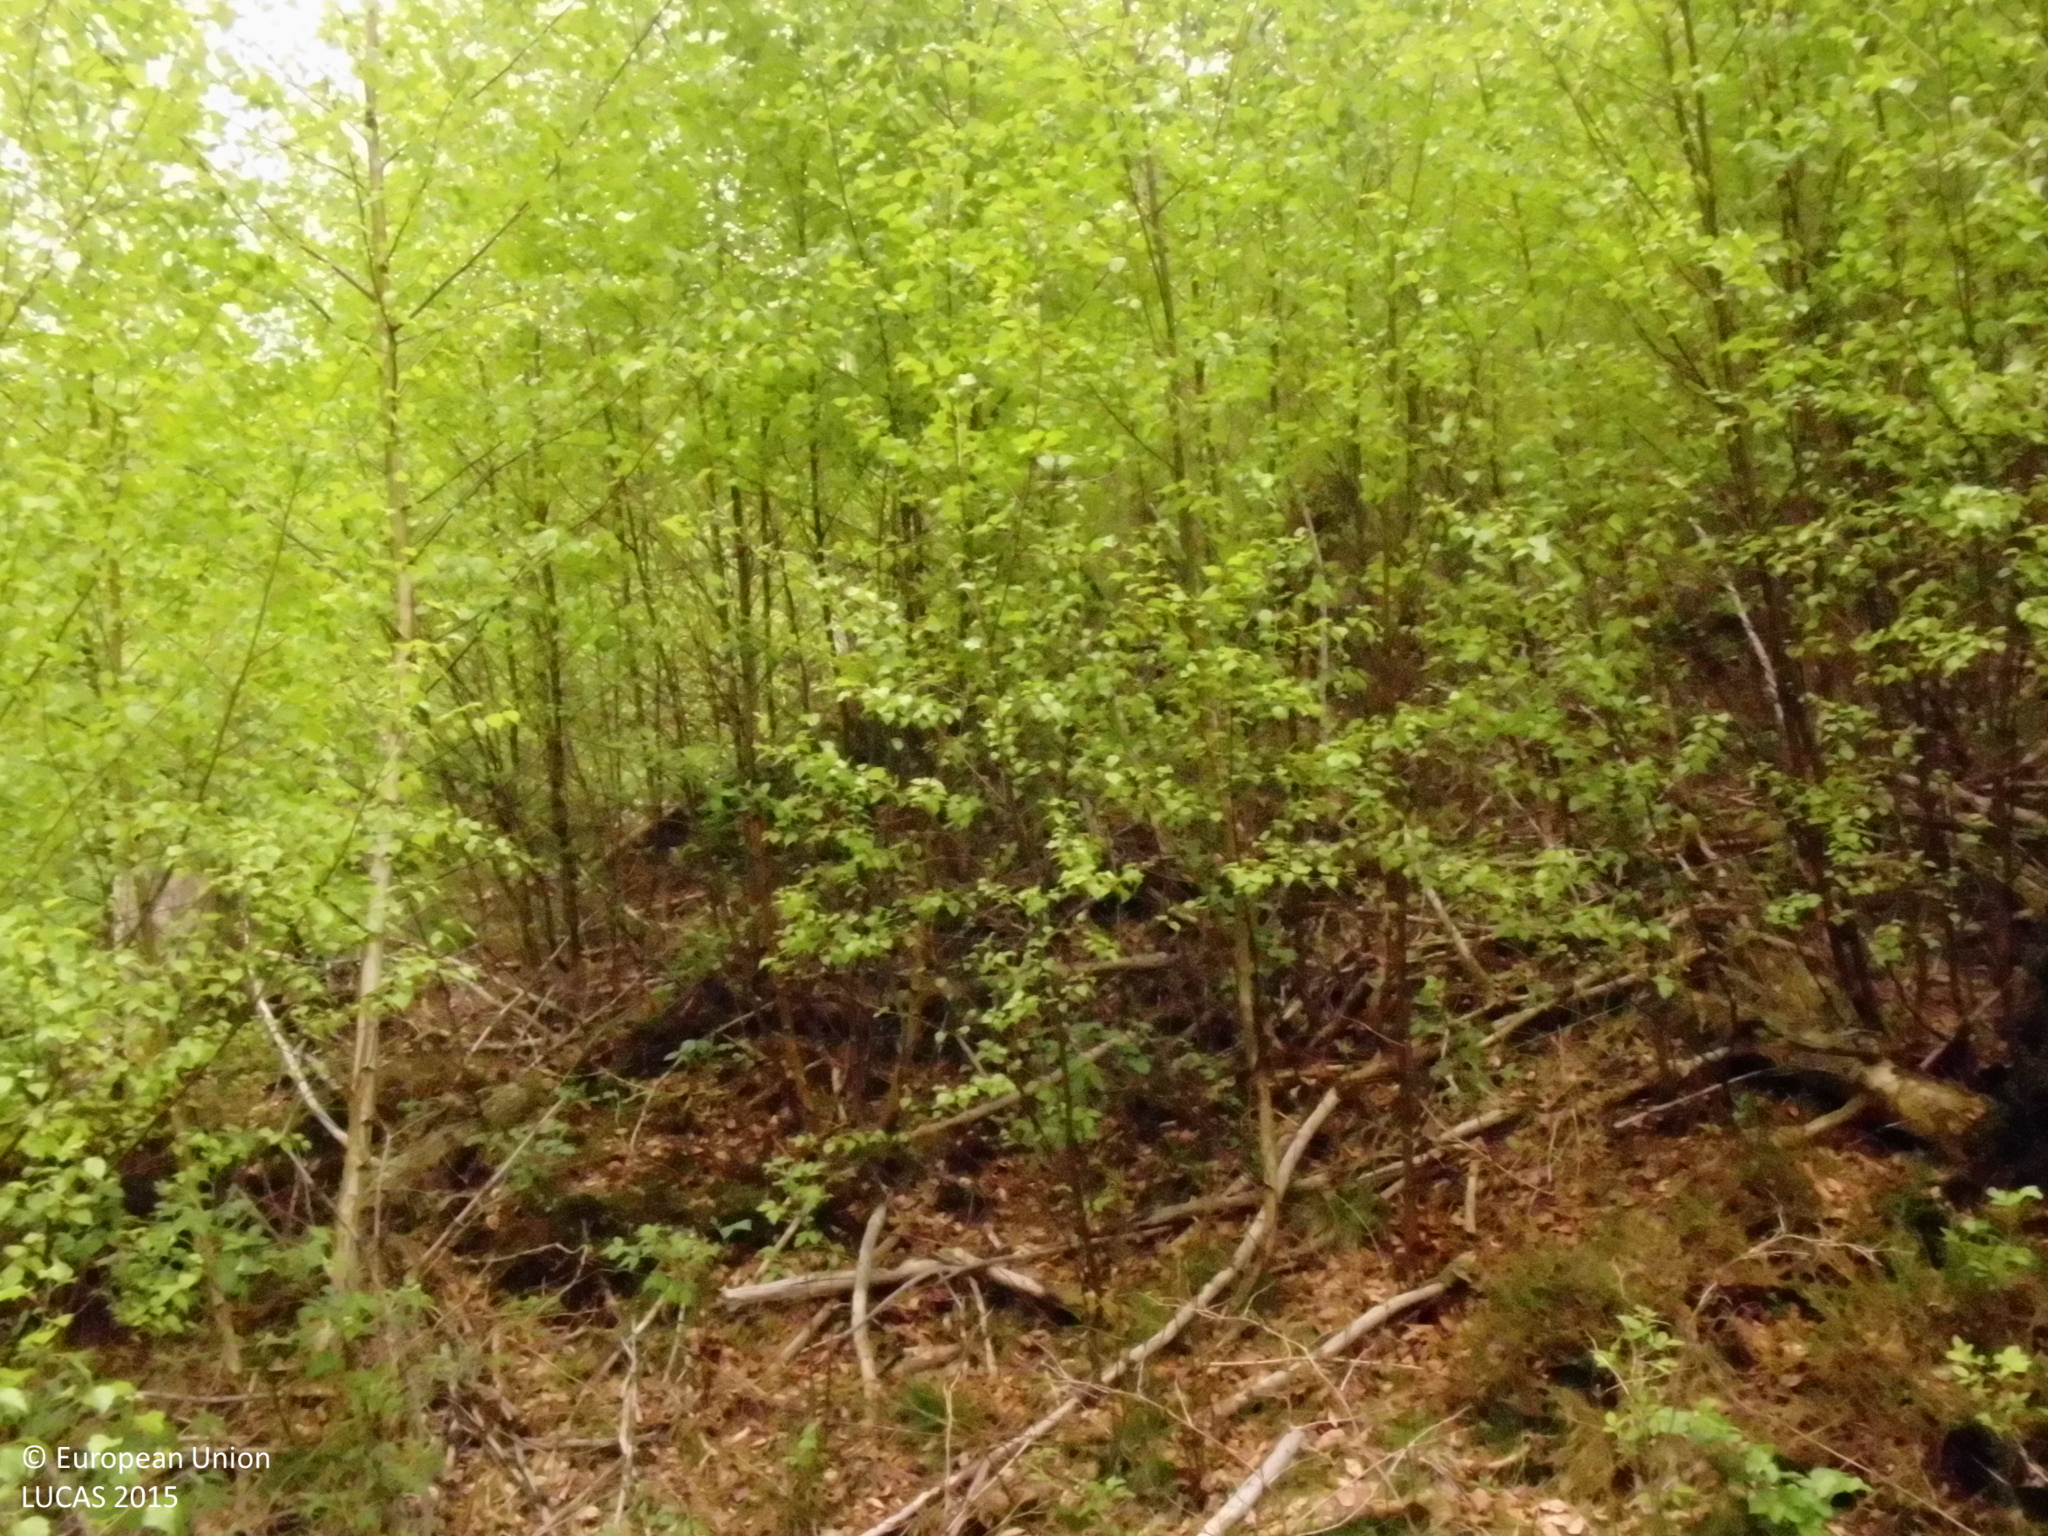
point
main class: Woodland
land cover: Broadleaved woodland
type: mesophytic deciduous forest
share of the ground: > 75 %
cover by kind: broadleaved forest trees 100 %
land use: Forestry
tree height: < 5 m
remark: Nursery
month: May
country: DE
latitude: 51.3060
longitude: 7.4038
